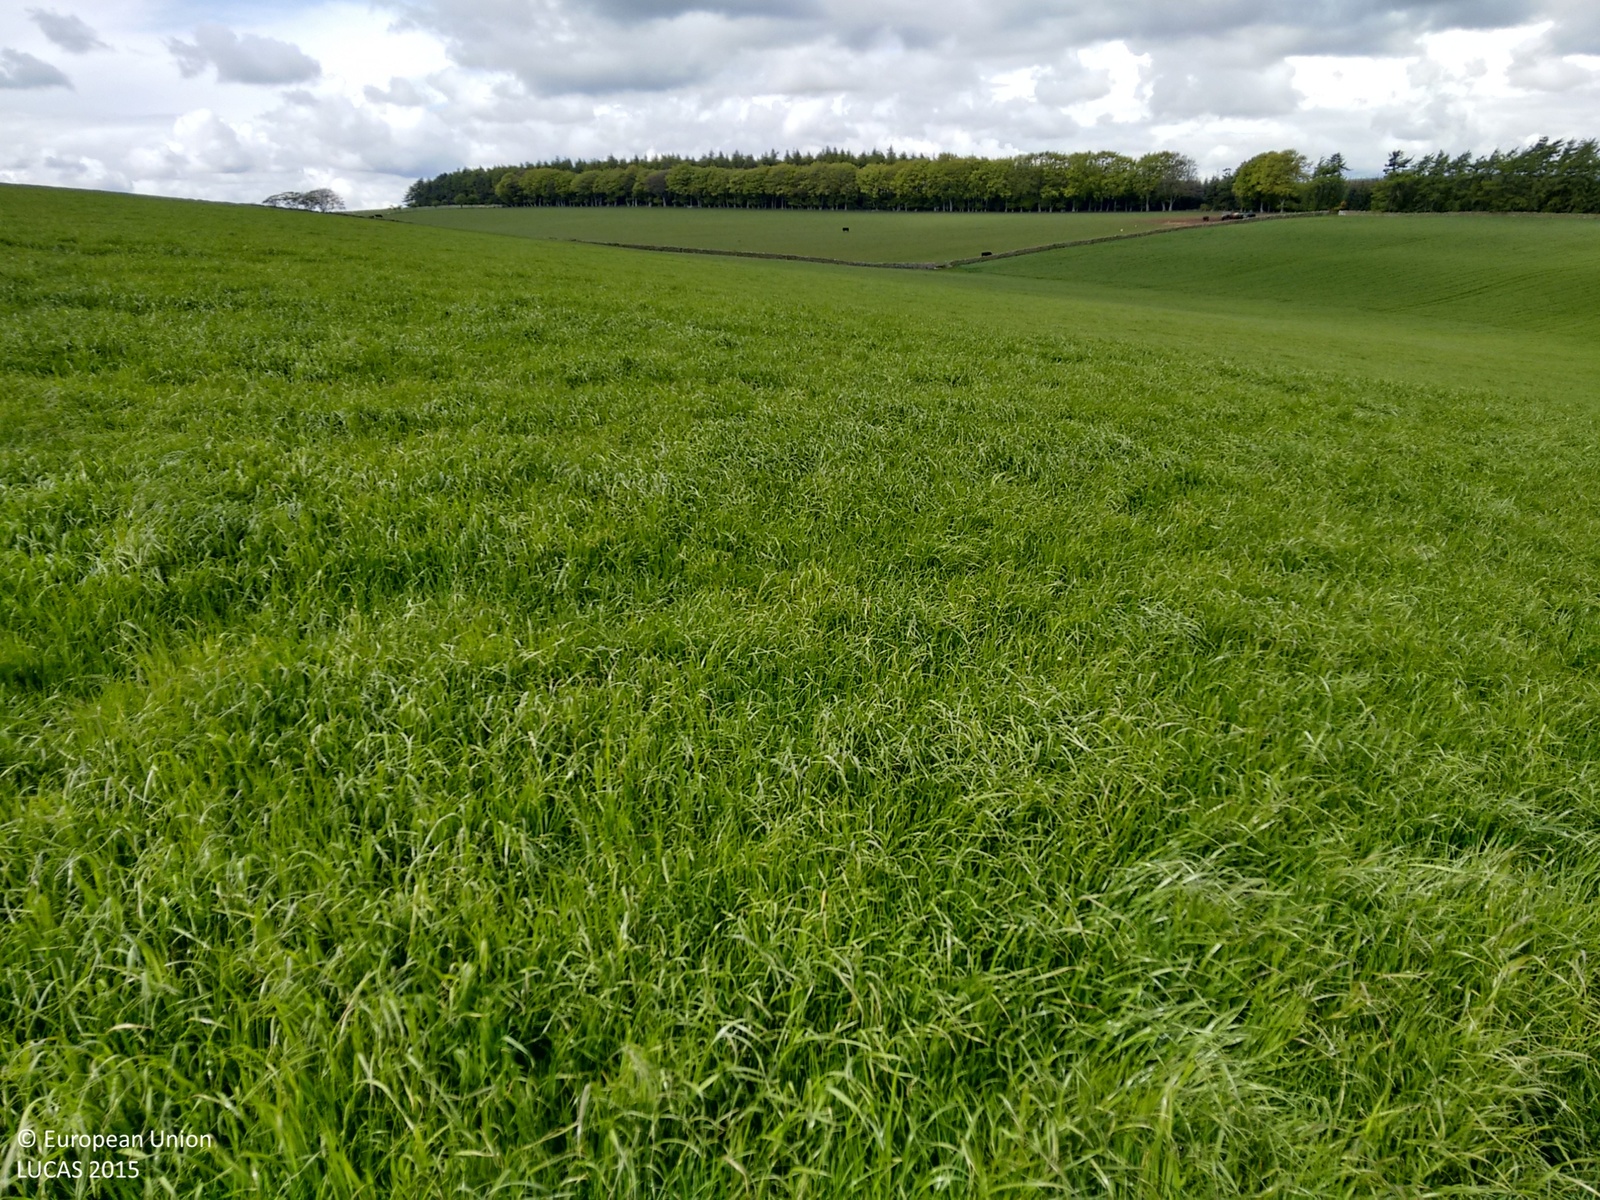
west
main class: Grassland
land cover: Grassland without tree/shrub cover
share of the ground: > 75 %
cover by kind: herbaceous plants 100 %
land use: Agriculture (excluding fallow land and kitchen gardens)
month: May
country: GB
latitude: 55.8621
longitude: -2.3441
